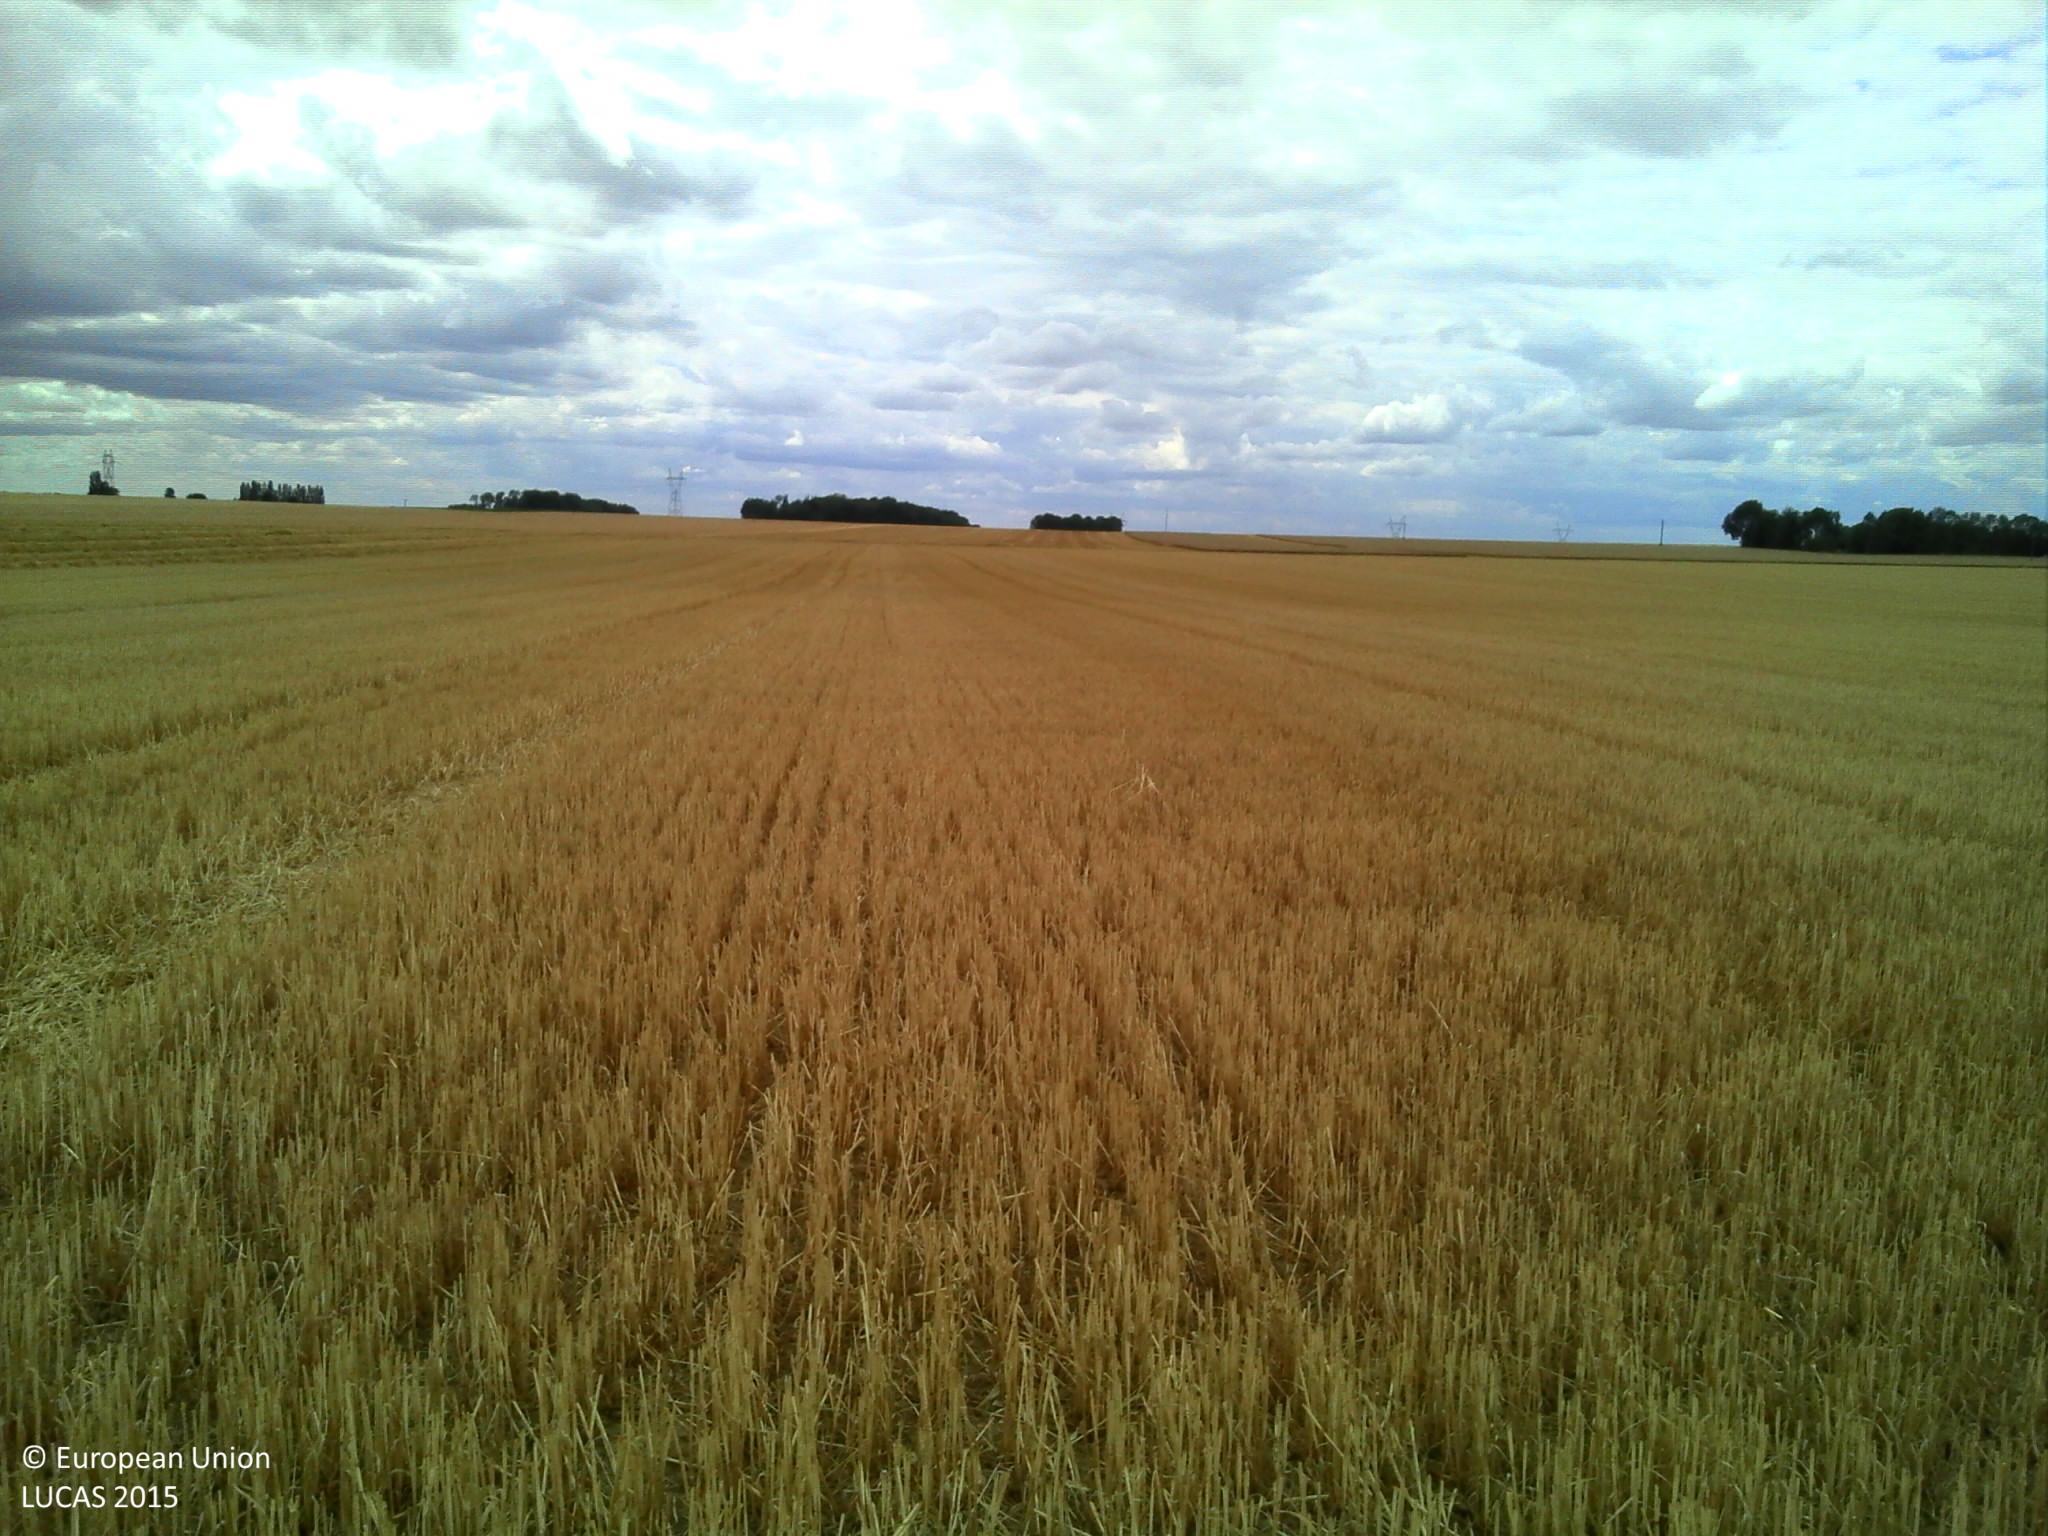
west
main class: Cropland
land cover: Common wheat
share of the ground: > 75 %
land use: Agriculture (excluding fallow land and kitchen gardens)
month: July
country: FR
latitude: 48.7671
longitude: 3.4219
